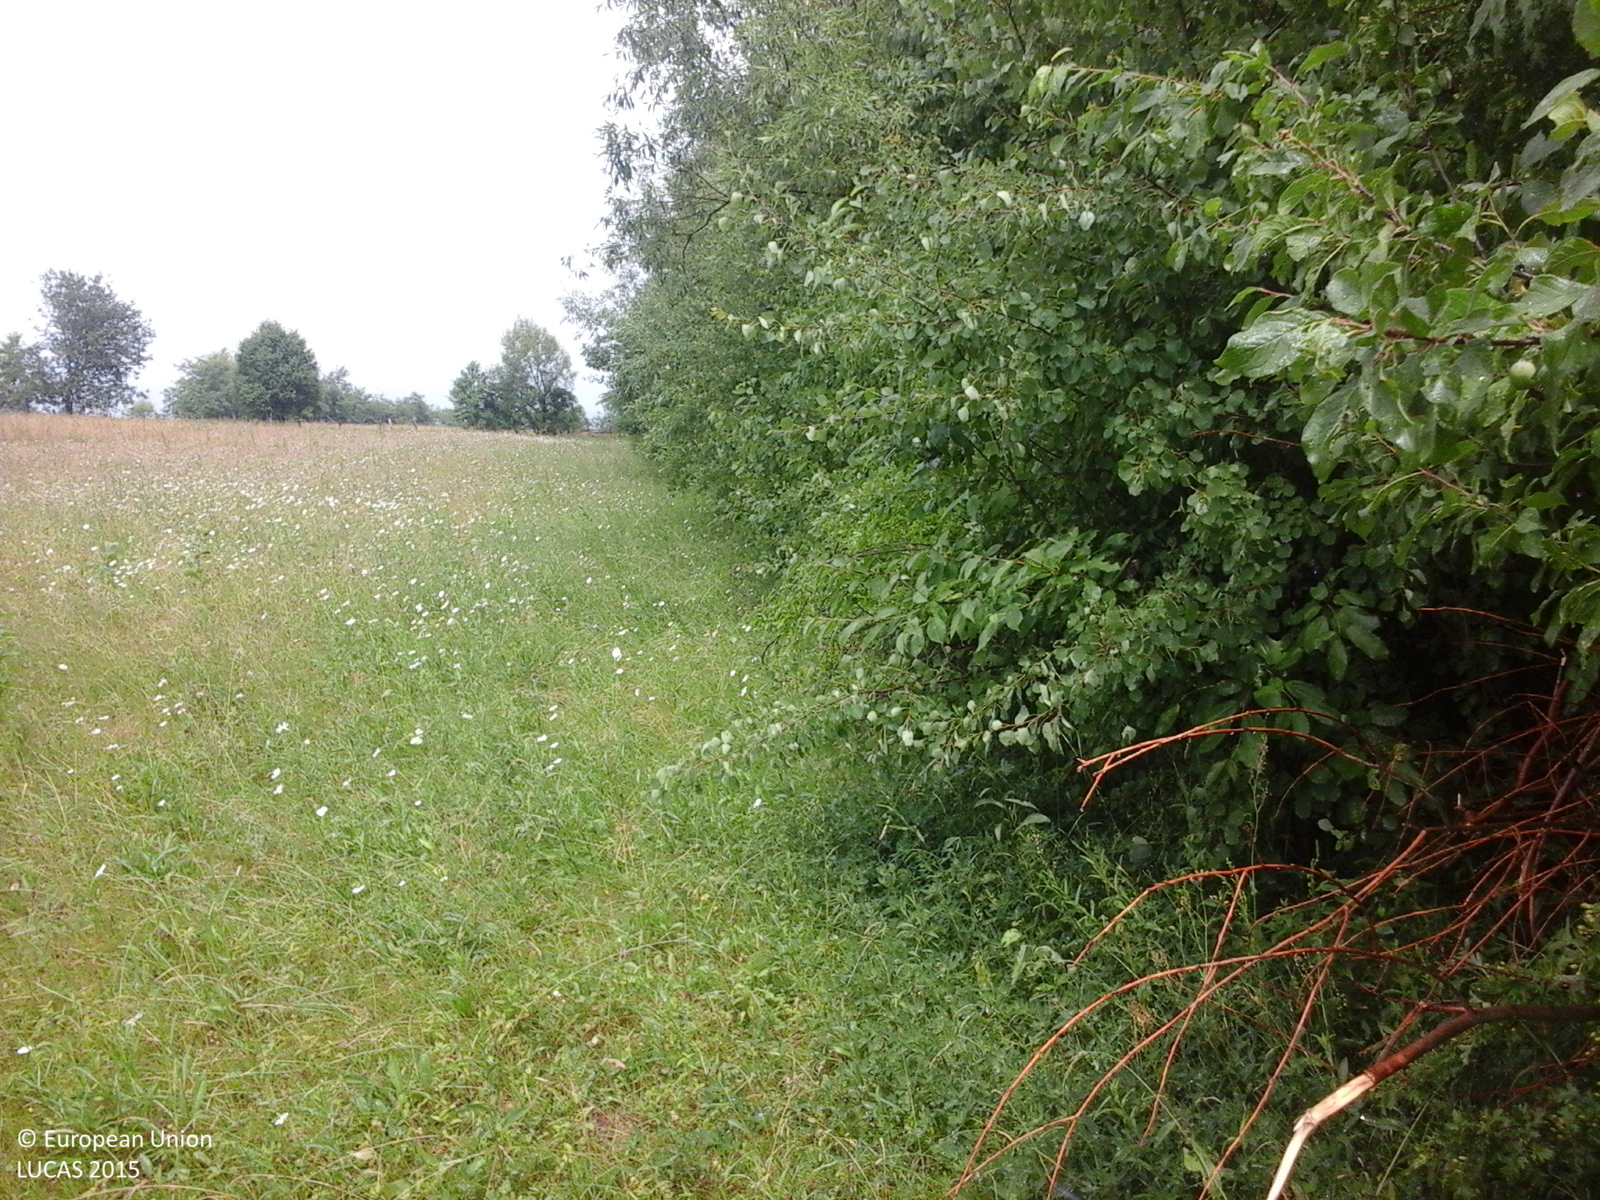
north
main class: Grassland
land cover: Grassland without tree/shrub cover
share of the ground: 50 - 75 %
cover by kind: herbaceous plants 100 %
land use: Agriculture (excluding fallow land and kitchen gardens)
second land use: Forestry
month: June
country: RO
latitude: 47.3525
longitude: 26.2721
